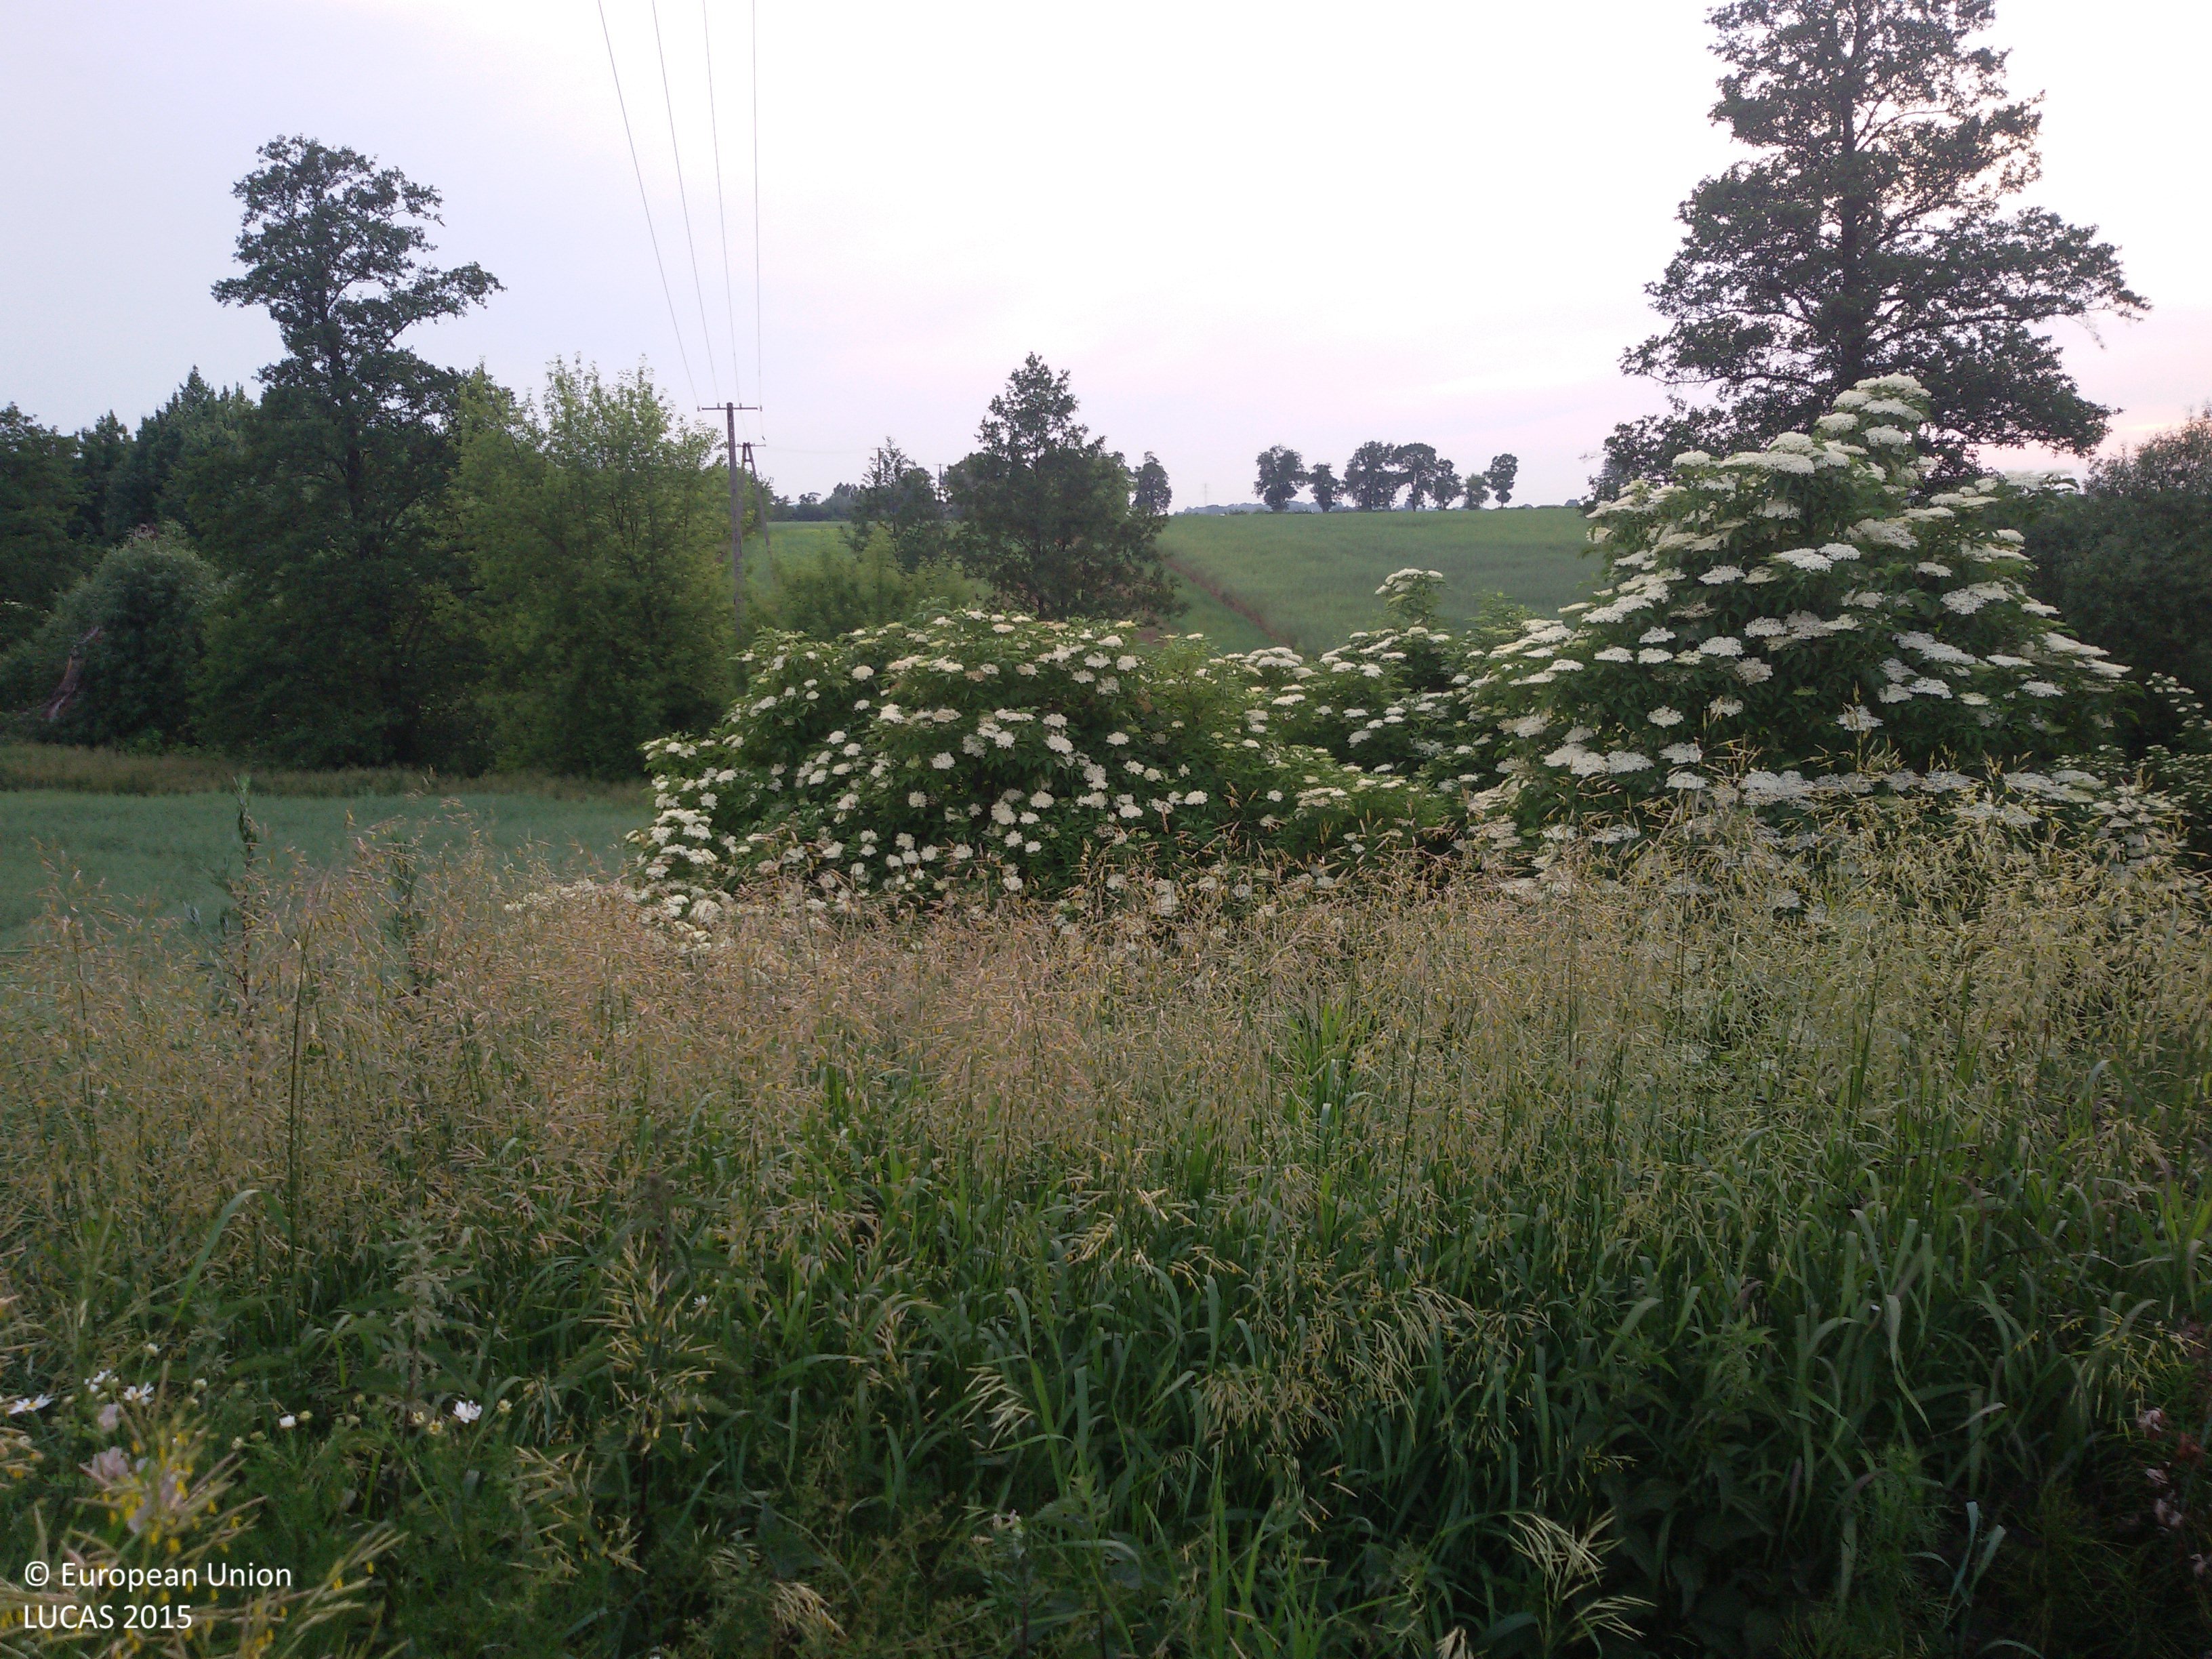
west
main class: Cropland
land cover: Rape and turnip rape
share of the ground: > 75 %
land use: Agriculture (excluding fallow land and kitchen gardens)
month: June
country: PL
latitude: 52.5392
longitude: 19.0318
